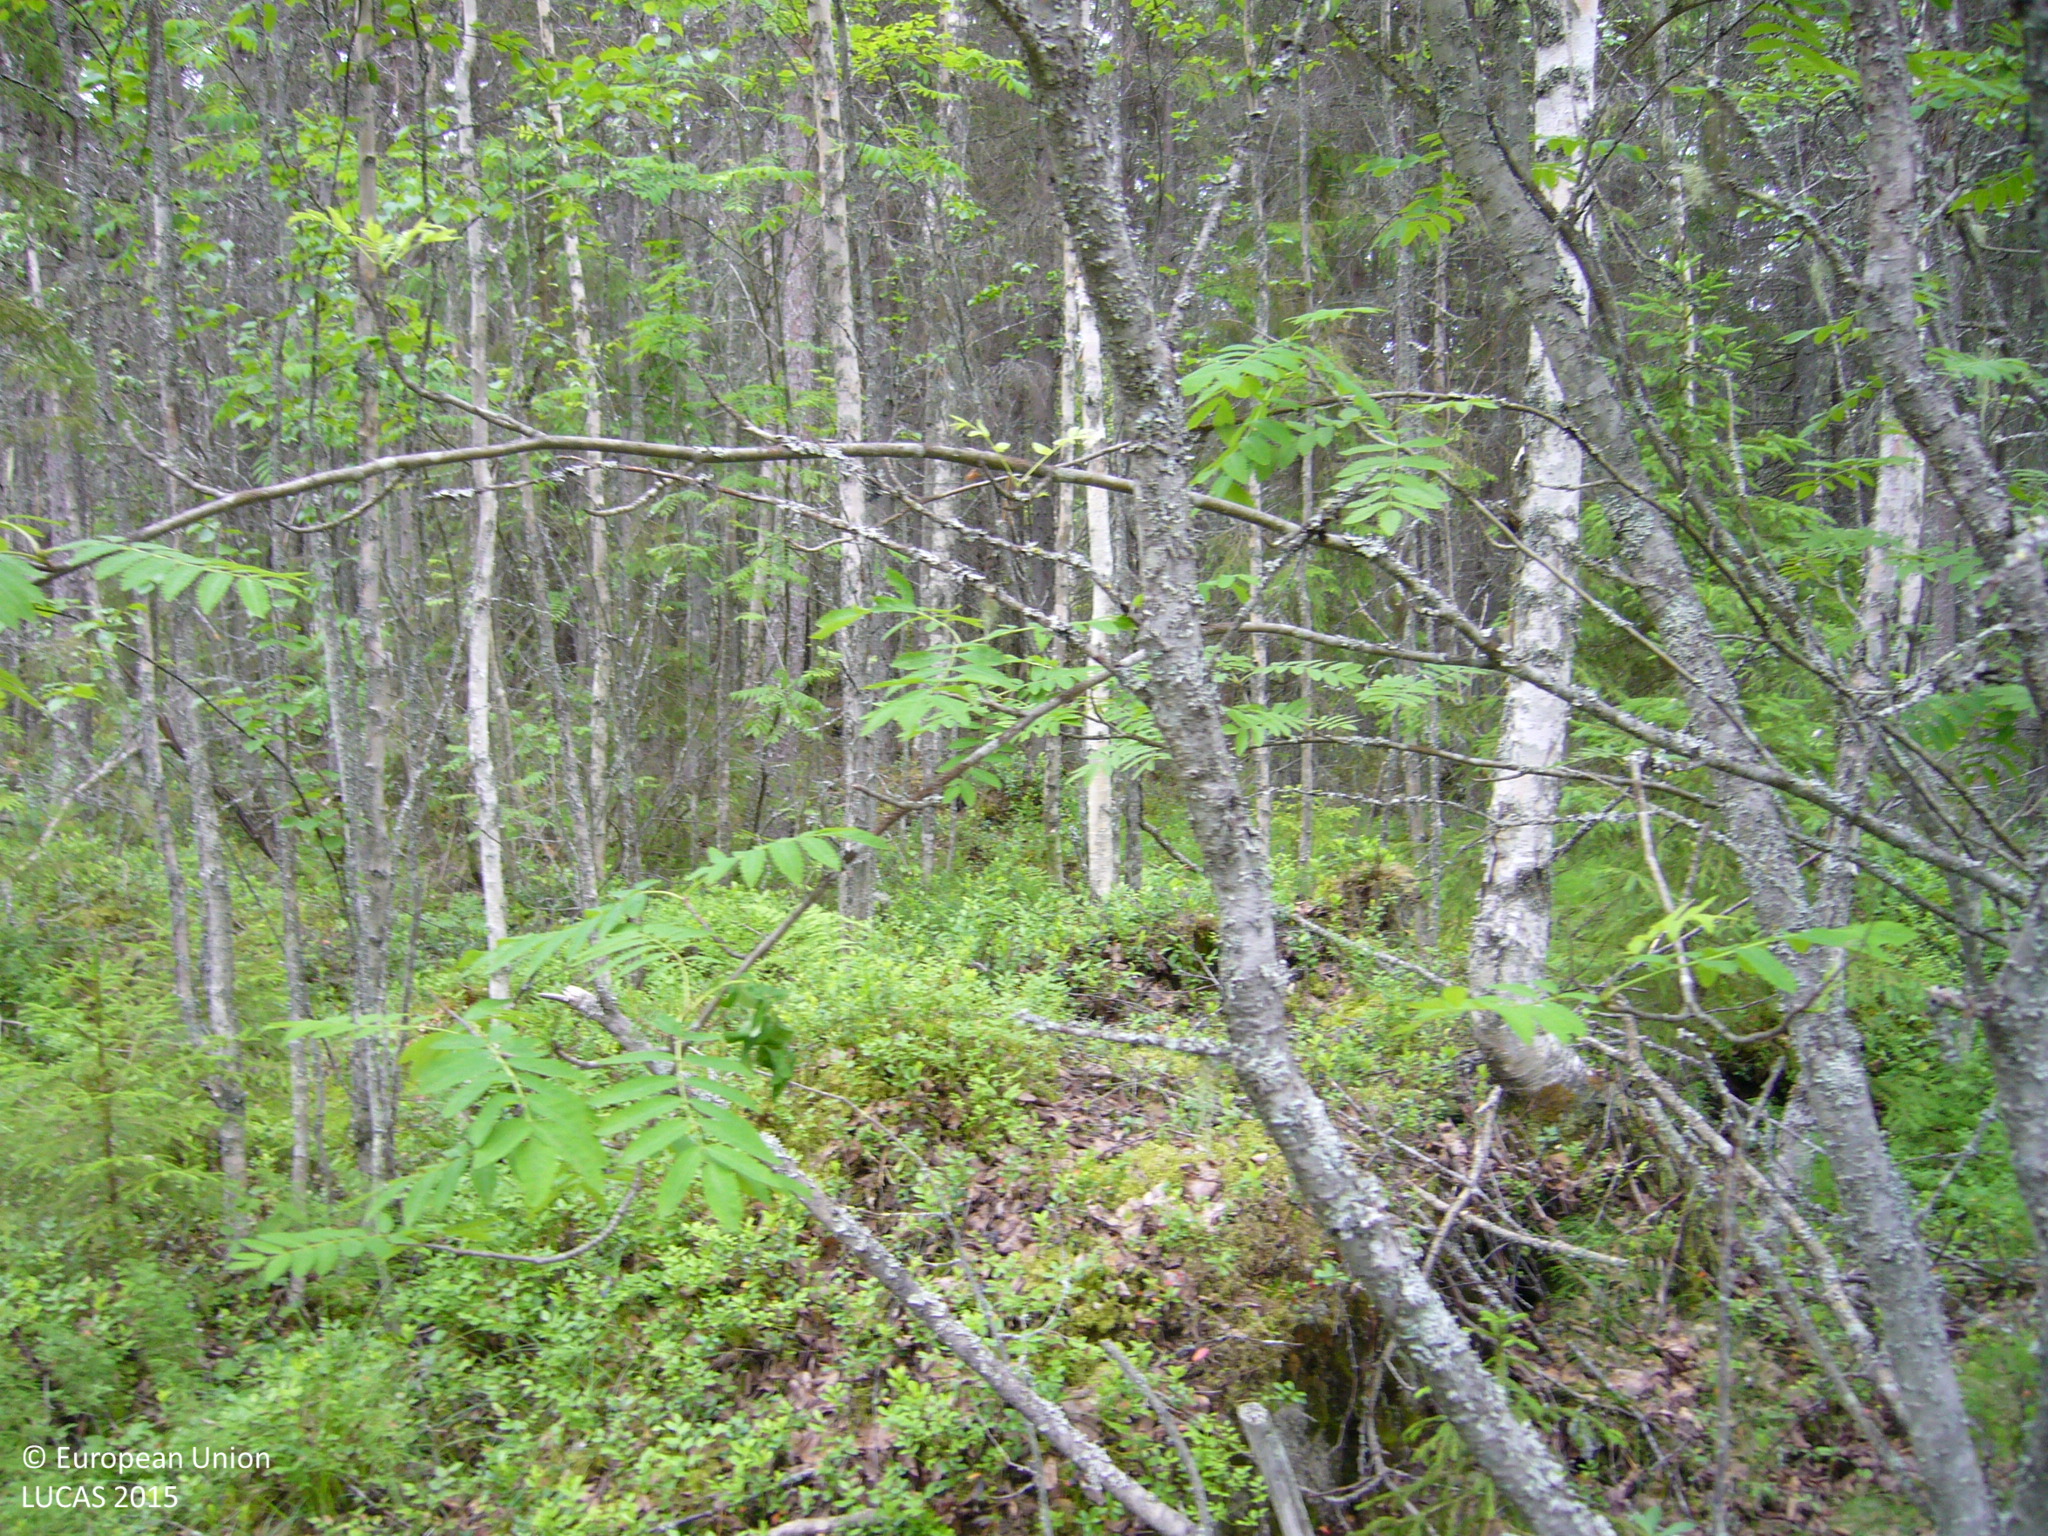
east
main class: Woodland
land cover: Other mixed woodland
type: boreal forest
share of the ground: > 75 %
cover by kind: broadleaved forest trees 55 %, coniferous forest trees 30 %, shrubs 15 %
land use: Forestry
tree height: > 5 m
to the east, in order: Other mixed woodland; Spruce dominated mixed woodland; Pine dominated mixed woodland; Spruce dominated mixed woodland; Inland fresh running water; Spruce dominated mixed woodland
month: July
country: FI
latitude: 63.4482
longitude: 26.1800
